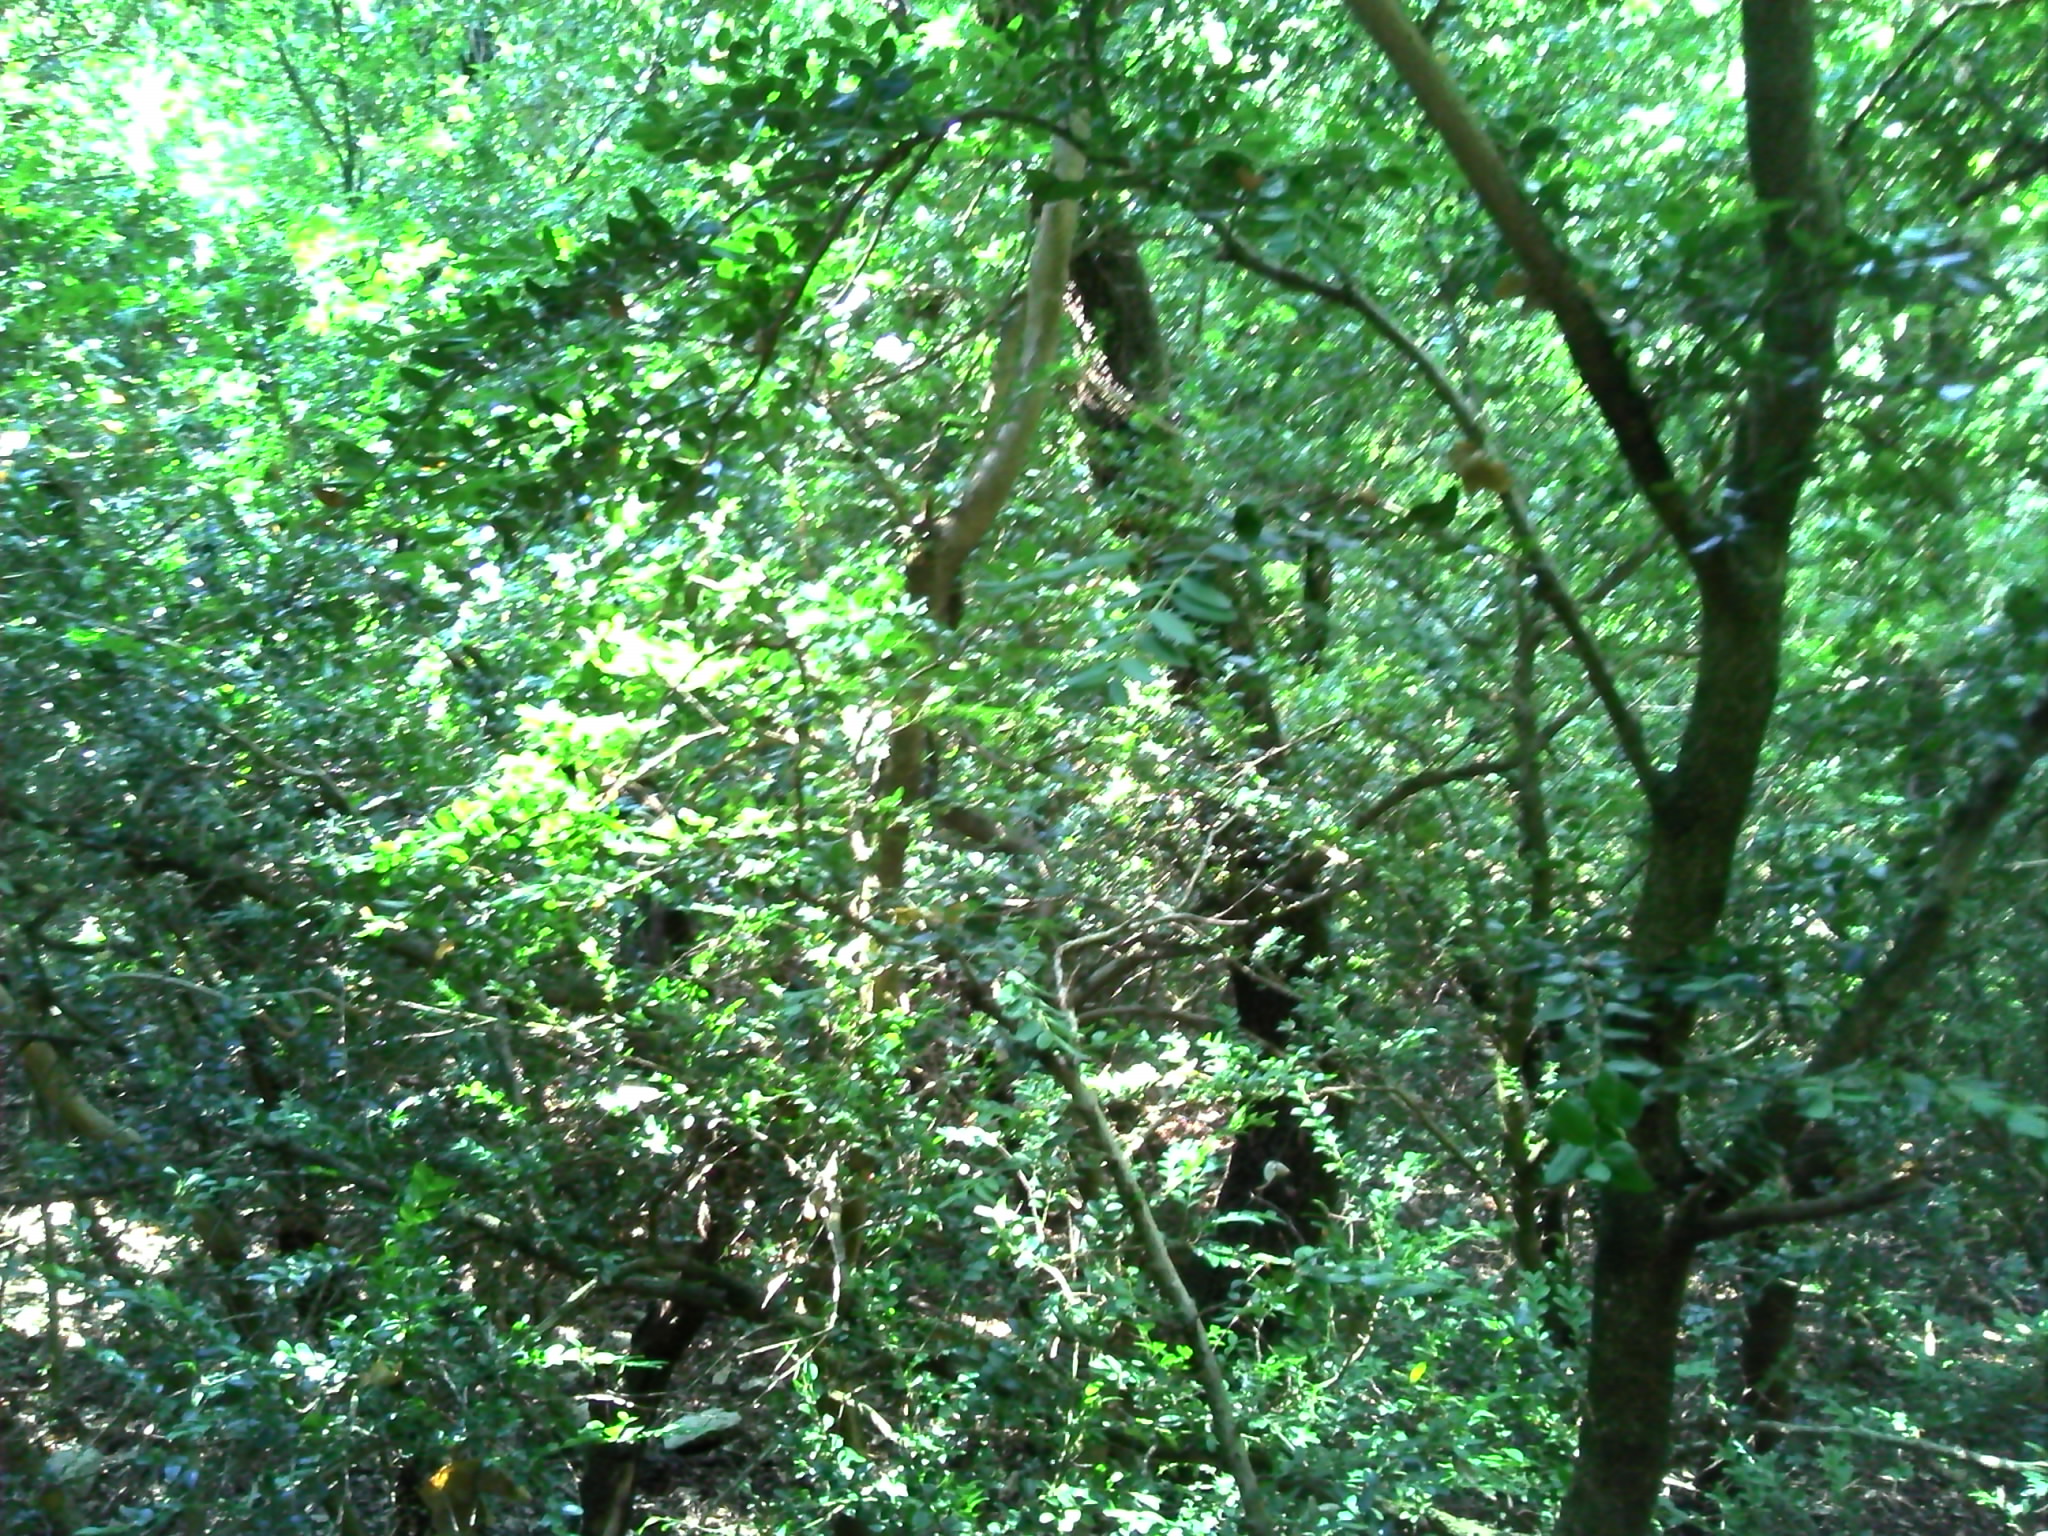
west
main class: Woodland
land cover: Broadleaved woodland
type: broadleaved evergreen forest
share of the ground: > 75 %
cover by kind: broadleaved forest trees 80 %, consolidated bare surface 15 %, herbaceous plants 5 %
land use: Forestry
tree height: > 5 m
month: August
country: FR
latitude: 43.9961
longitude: 4.6587
